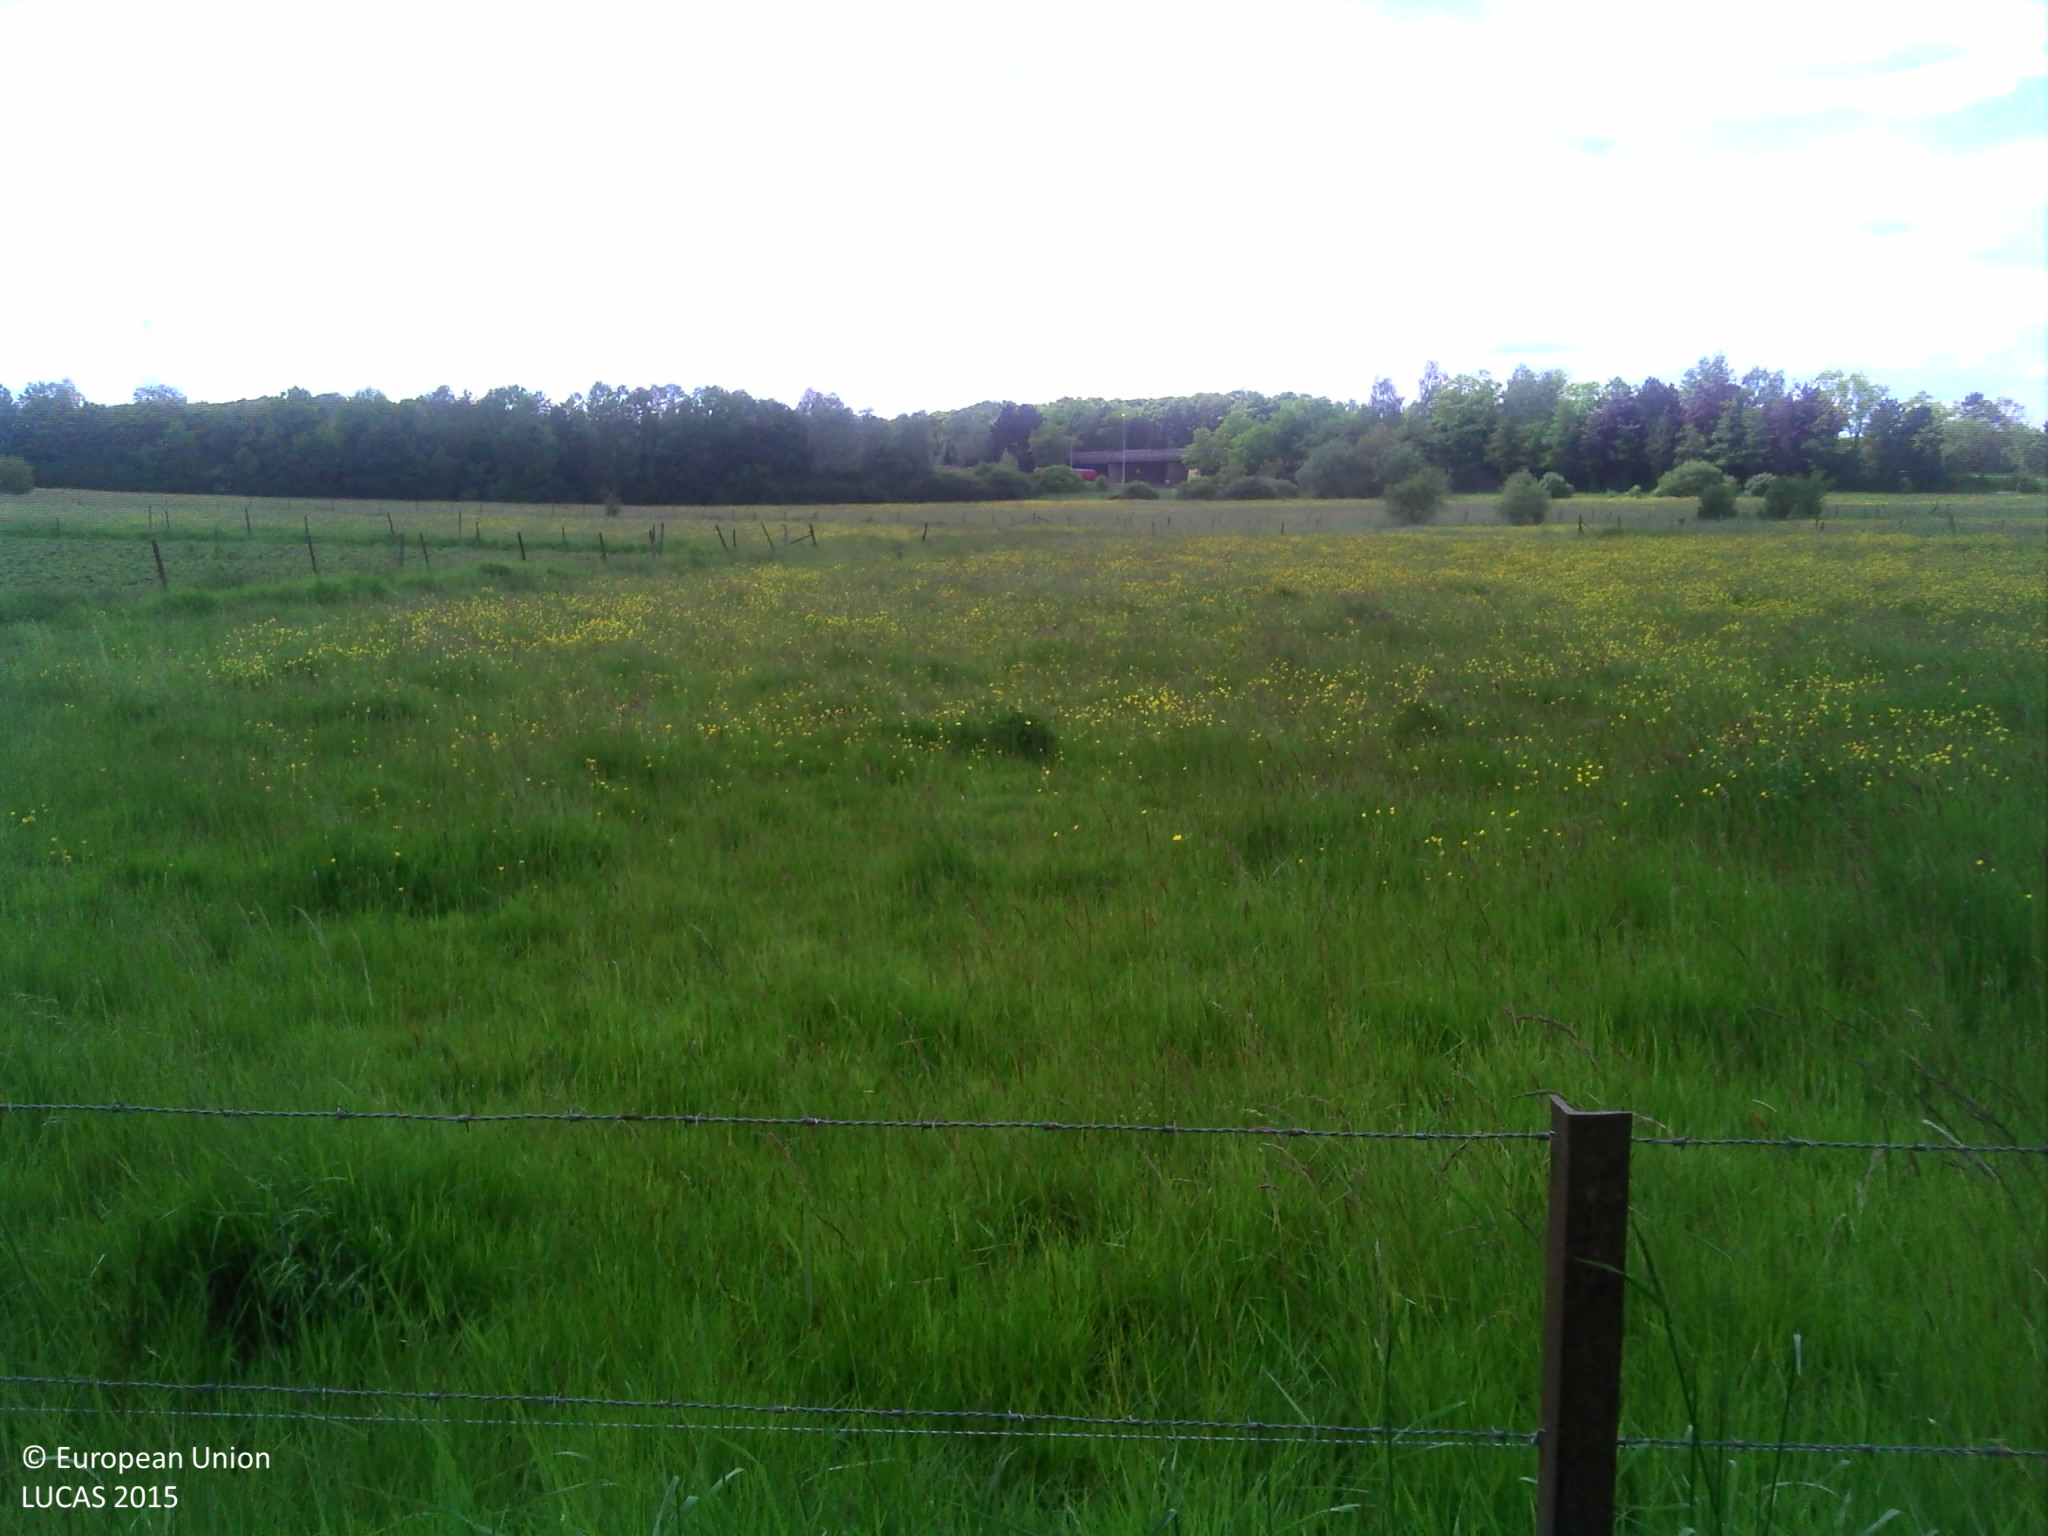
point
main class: Grassland
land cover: Grassland without tree/shrub cover
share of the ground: > 75 %
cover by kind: herbaceous plants 100 %
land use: Agriculture (excluding fallow land and kitchen gardens)
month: May
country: LU
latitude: 49.5949
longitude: 6.0841
